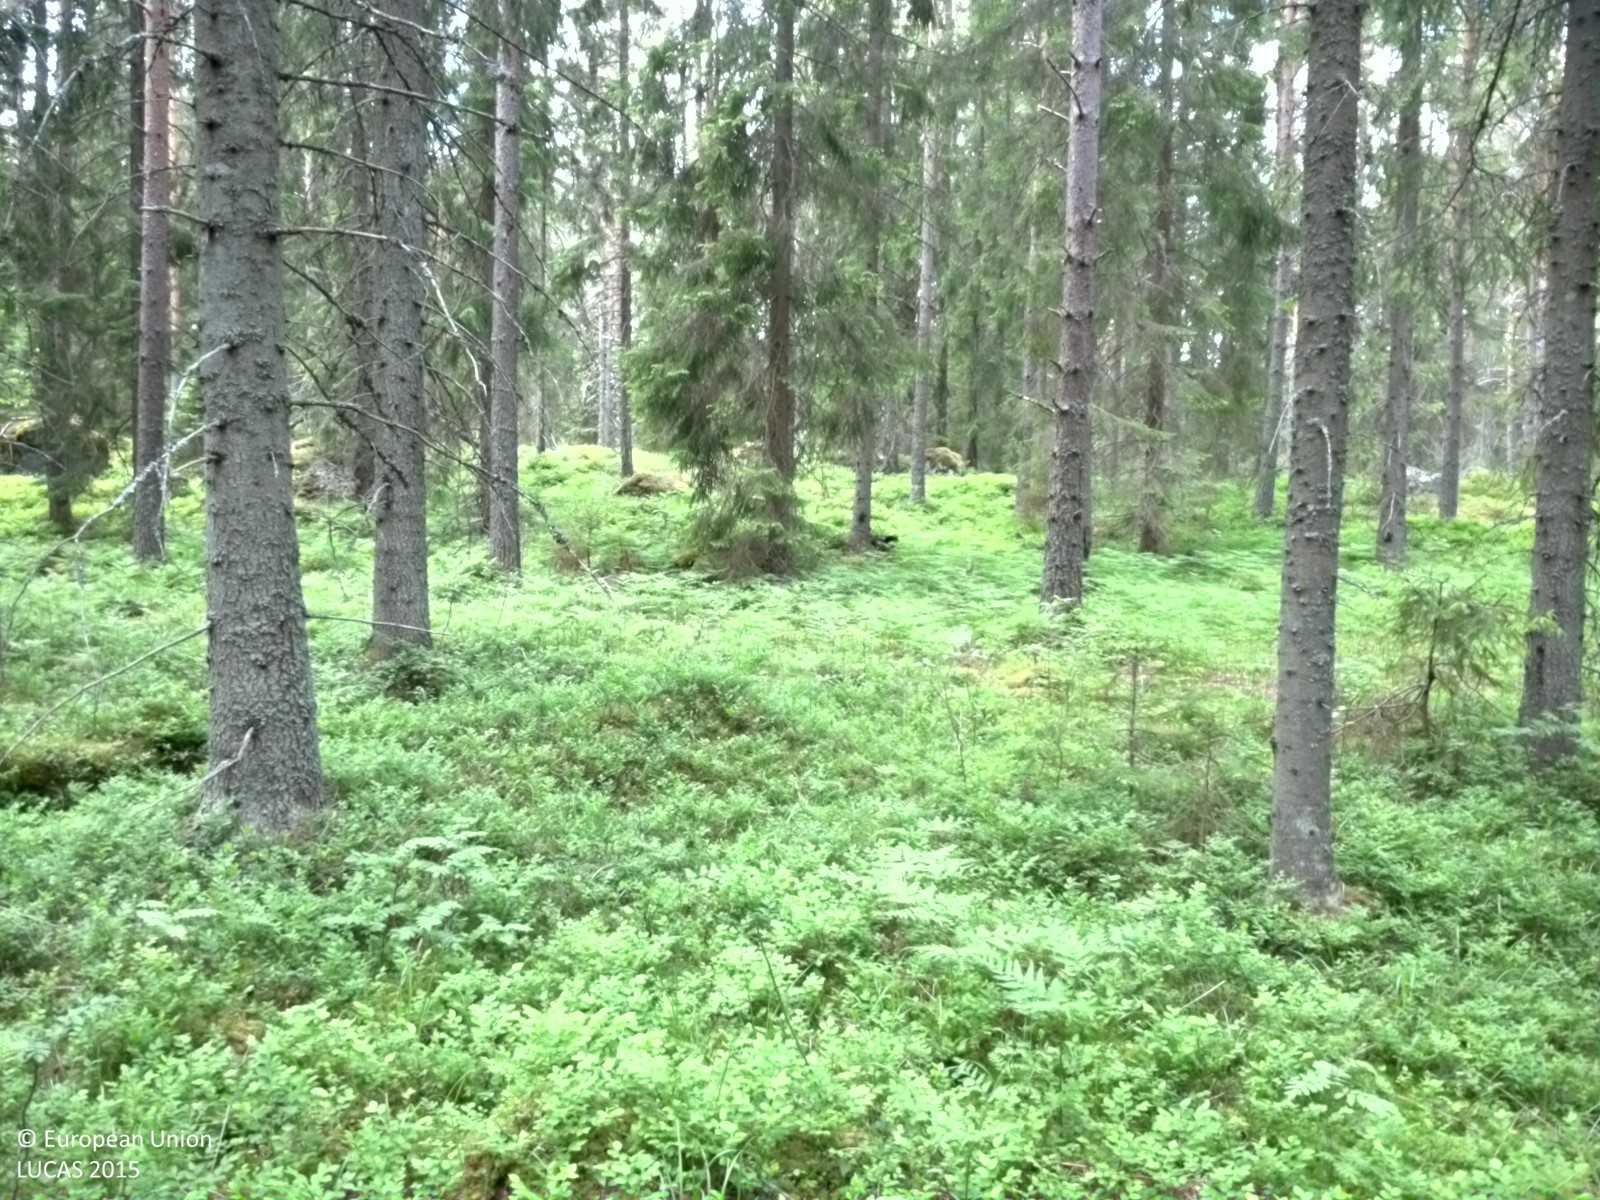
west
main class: Woodland
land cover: Spruce dominated coniferous woodland
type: boreal forest
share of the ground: > 75 %
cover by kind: coniferous forest trees 70 %, shrubs 20 %, broadleaved forest trees 5 %, herbaceous plants 5 %
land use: Forestry
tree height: > 5 m
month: June
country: SE
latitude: 60.3449
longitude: 17.1112
